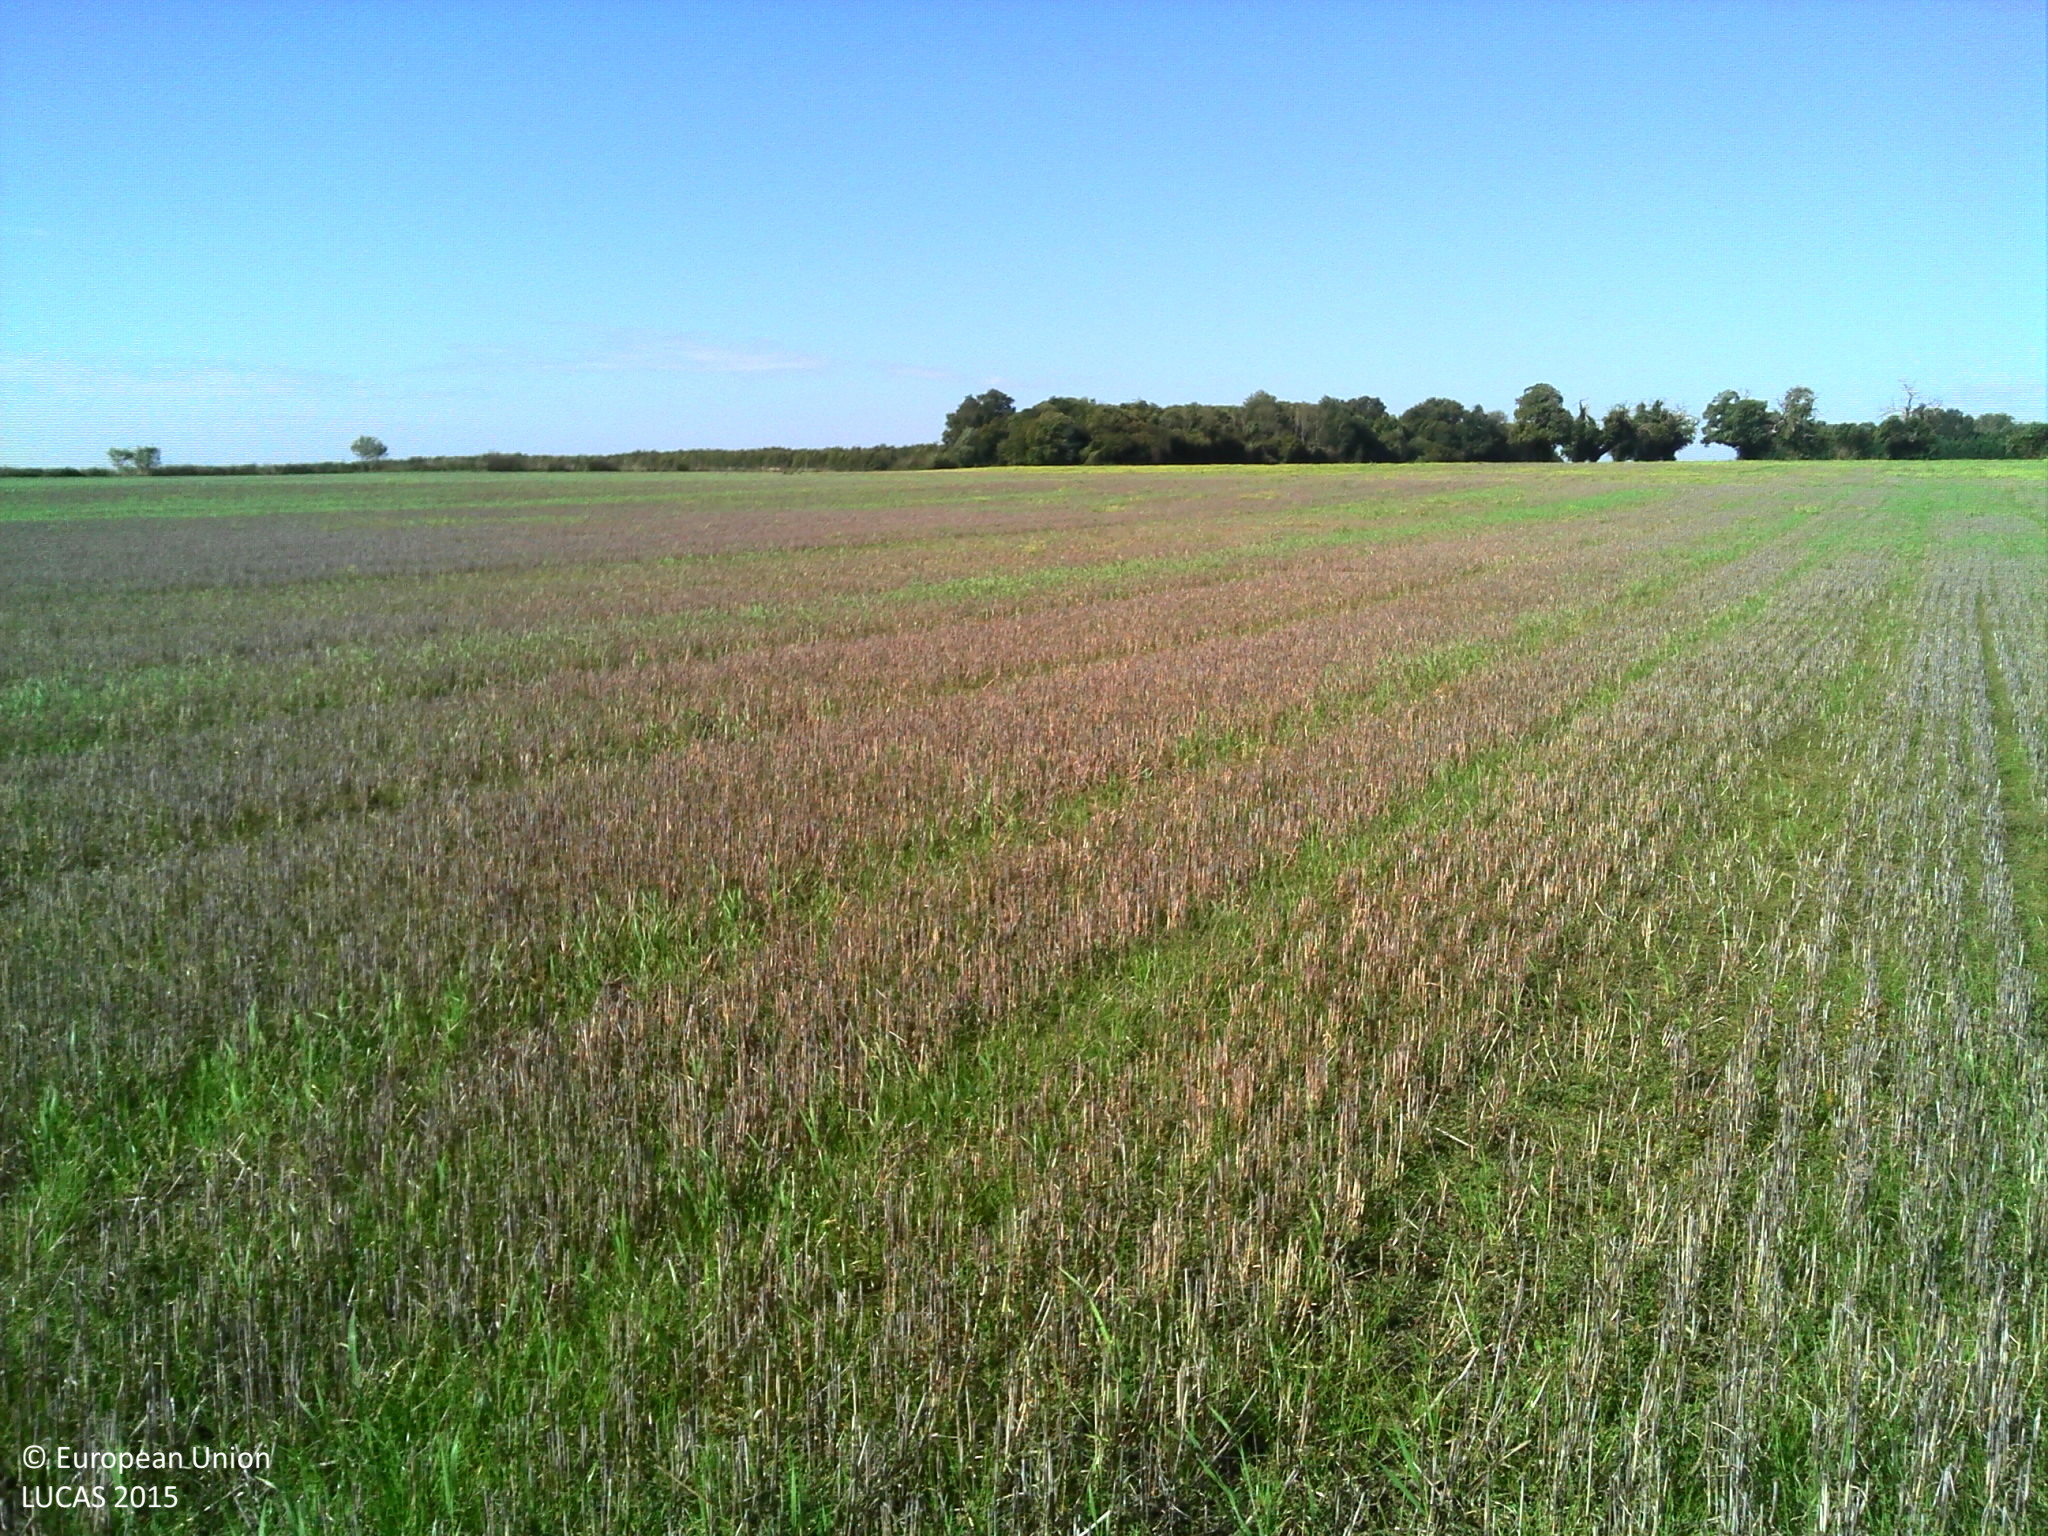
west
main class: Cropland
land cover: Common wheat
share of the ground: > 75 %
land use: Agriculture (excluding fallow land and kitchen gardens)
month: September
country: FR
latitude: 46.5221
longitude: -1.0475
